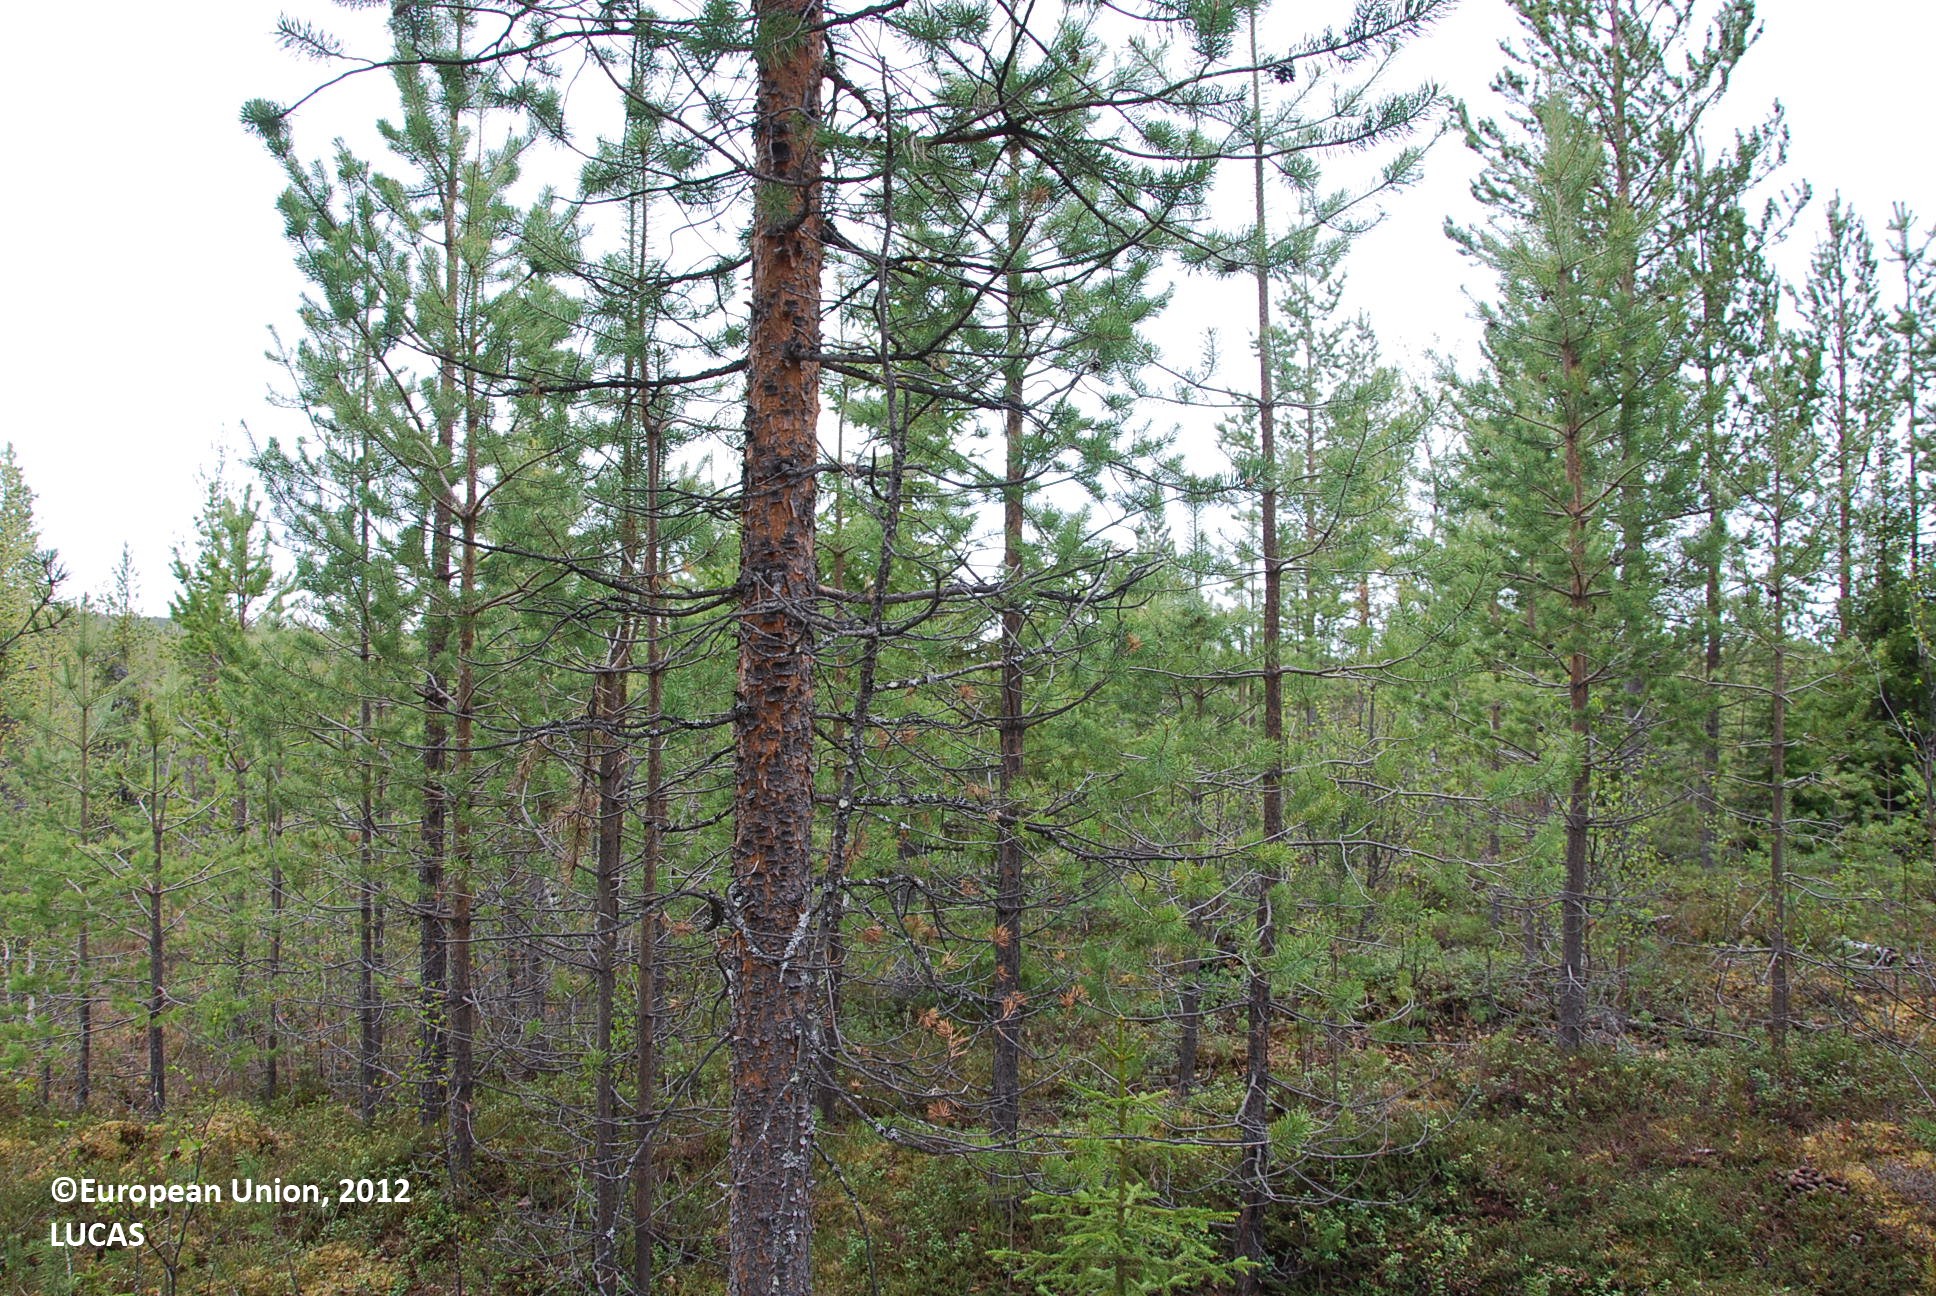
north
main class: Woodland
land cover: Pine dominated coniferous woodland
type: boreal forest
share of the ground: > 75 %
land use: Forestry
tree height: > 5 m
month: June
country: FI
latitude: 66.7874
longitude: 28.2066
